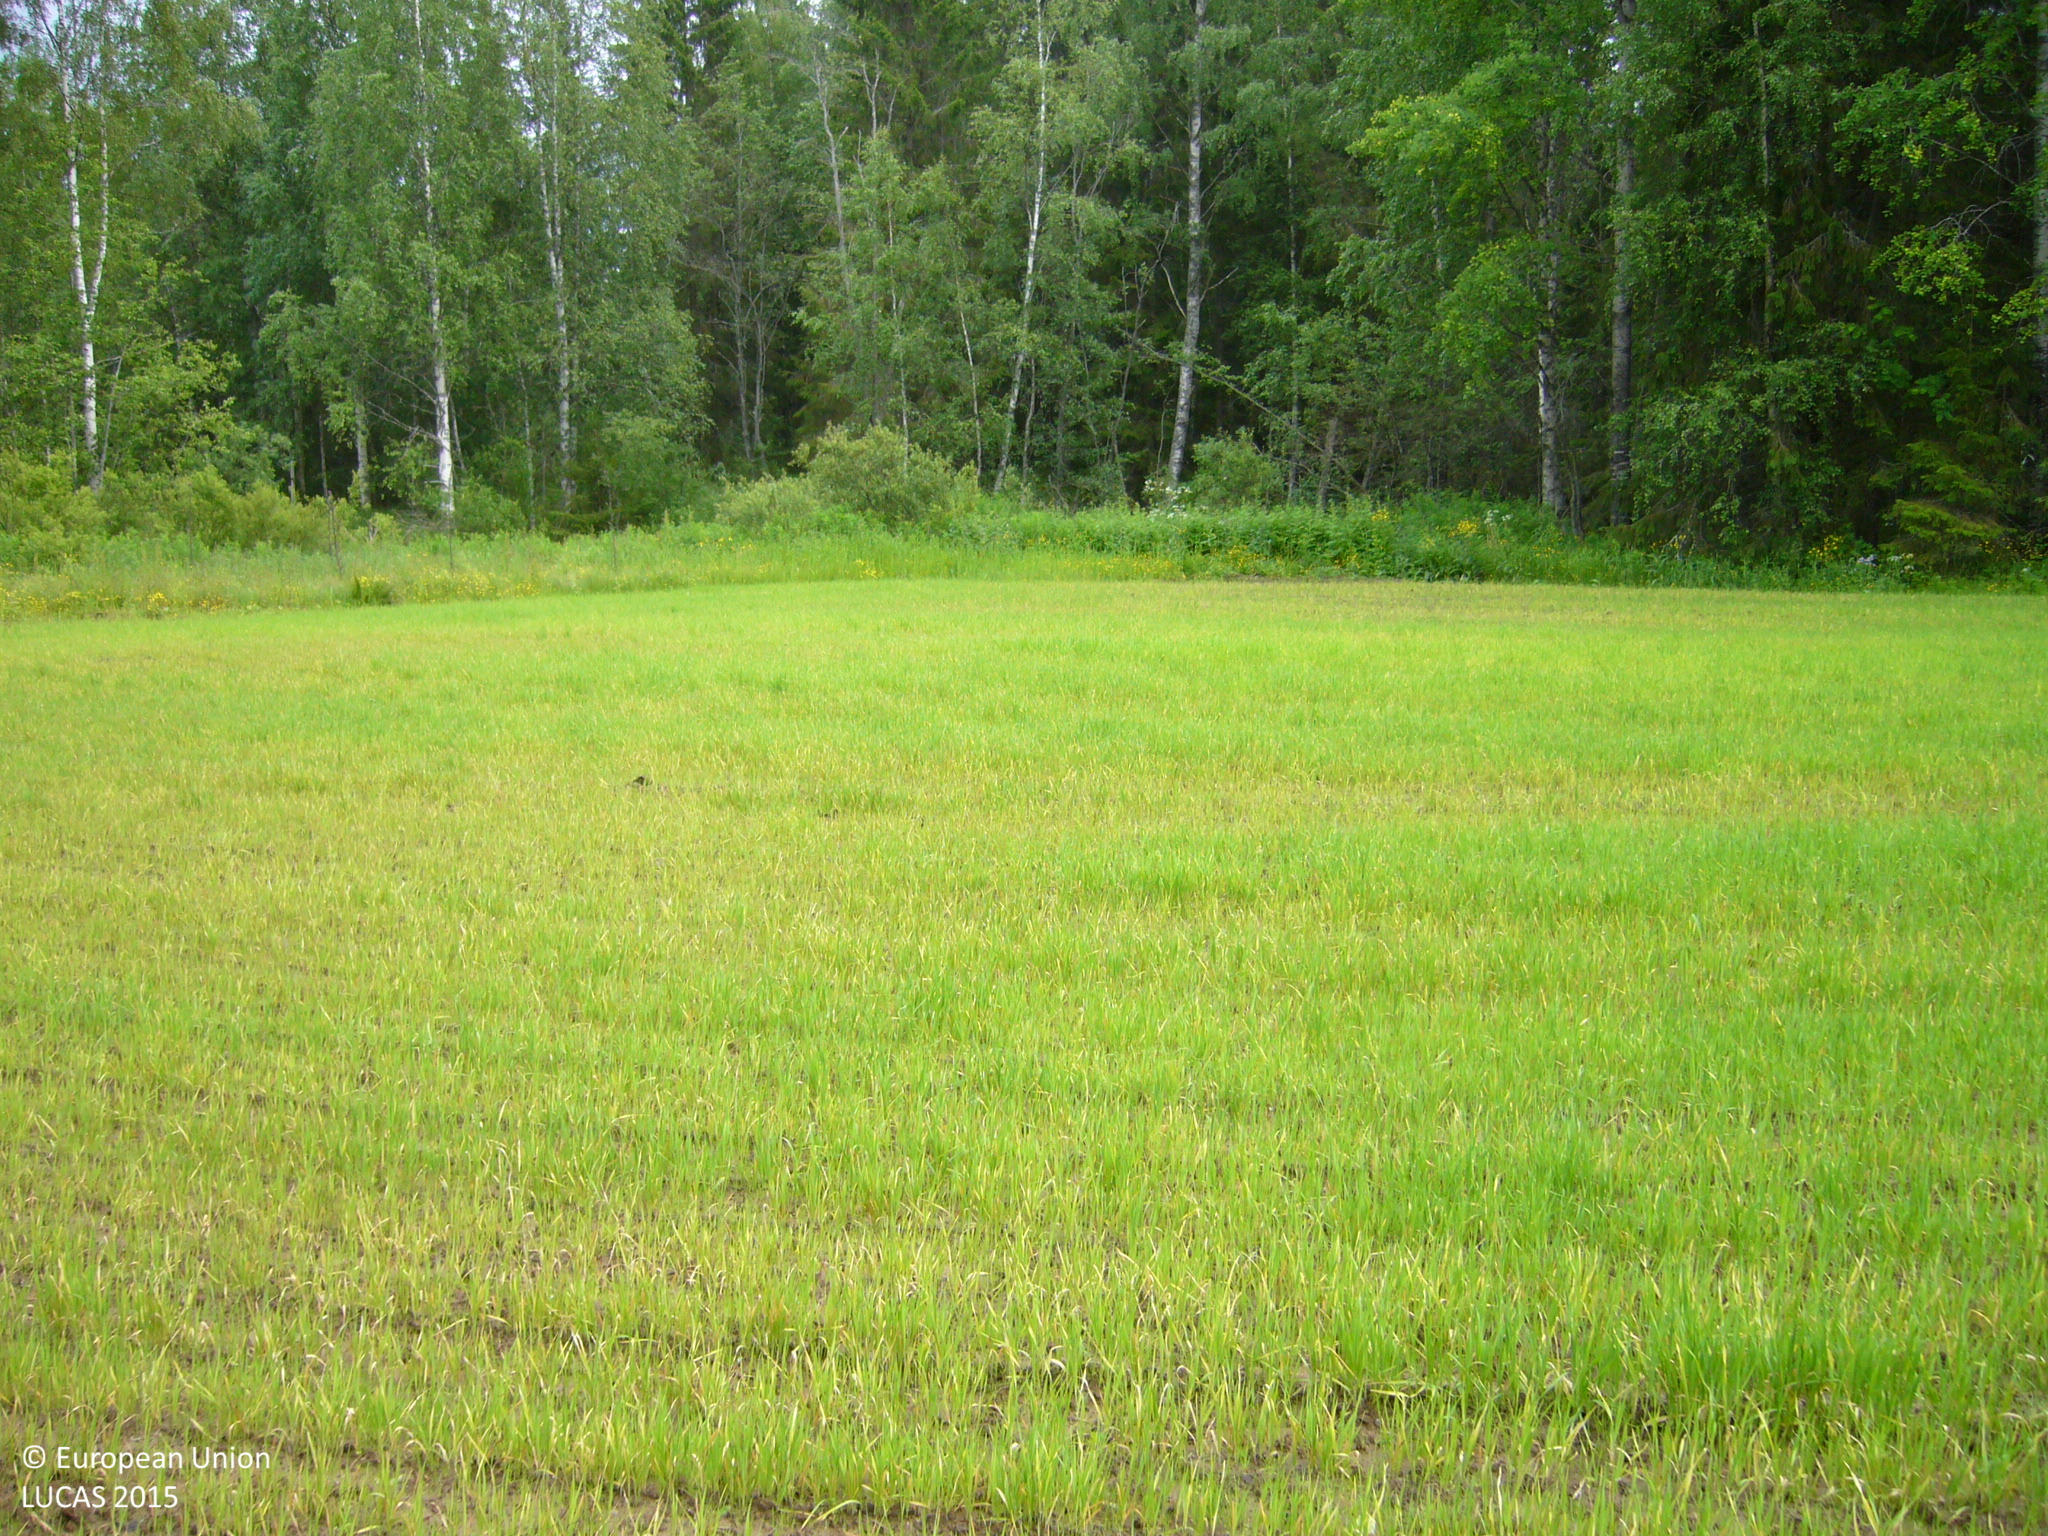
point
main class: Cropland
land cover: Barley
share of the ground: > 75 %
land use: Agriculture (excluding fallow land and kitchen gardens)
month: July
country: FI
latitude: 63.4452
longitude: 25.3153
